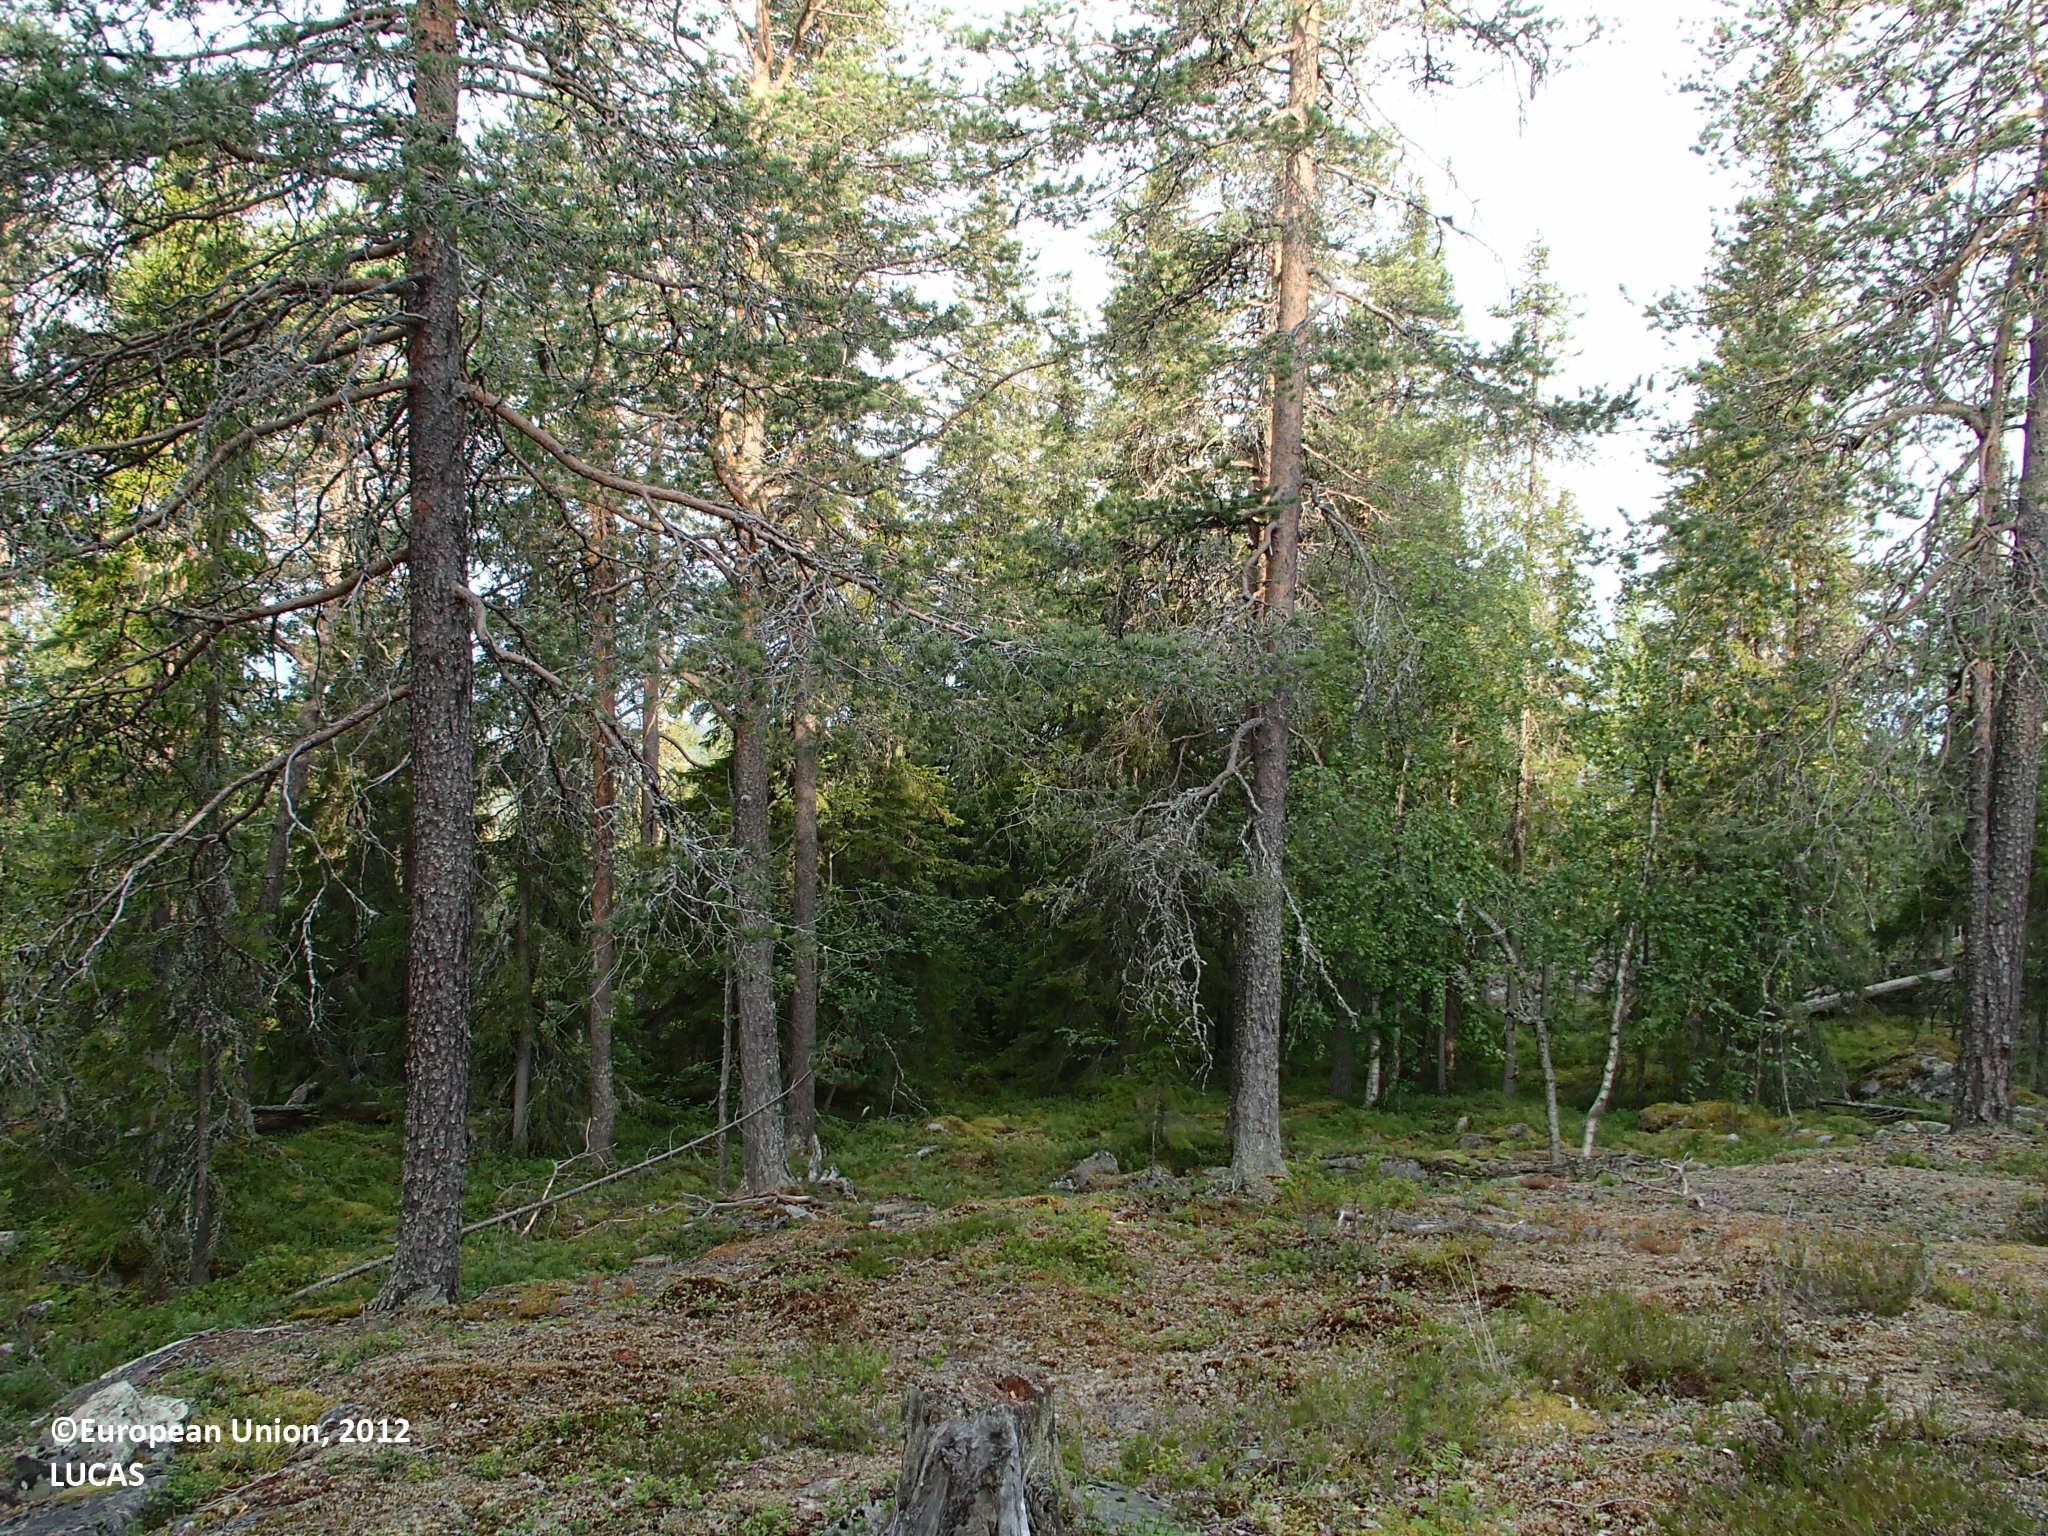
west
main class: Woodland
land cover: Other mixed woodland
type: boreal forest
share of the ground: 25 - 50 %
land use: Forestry
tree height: > 5 m
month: July
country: FI
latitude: 66.6217
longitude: 25.5792
